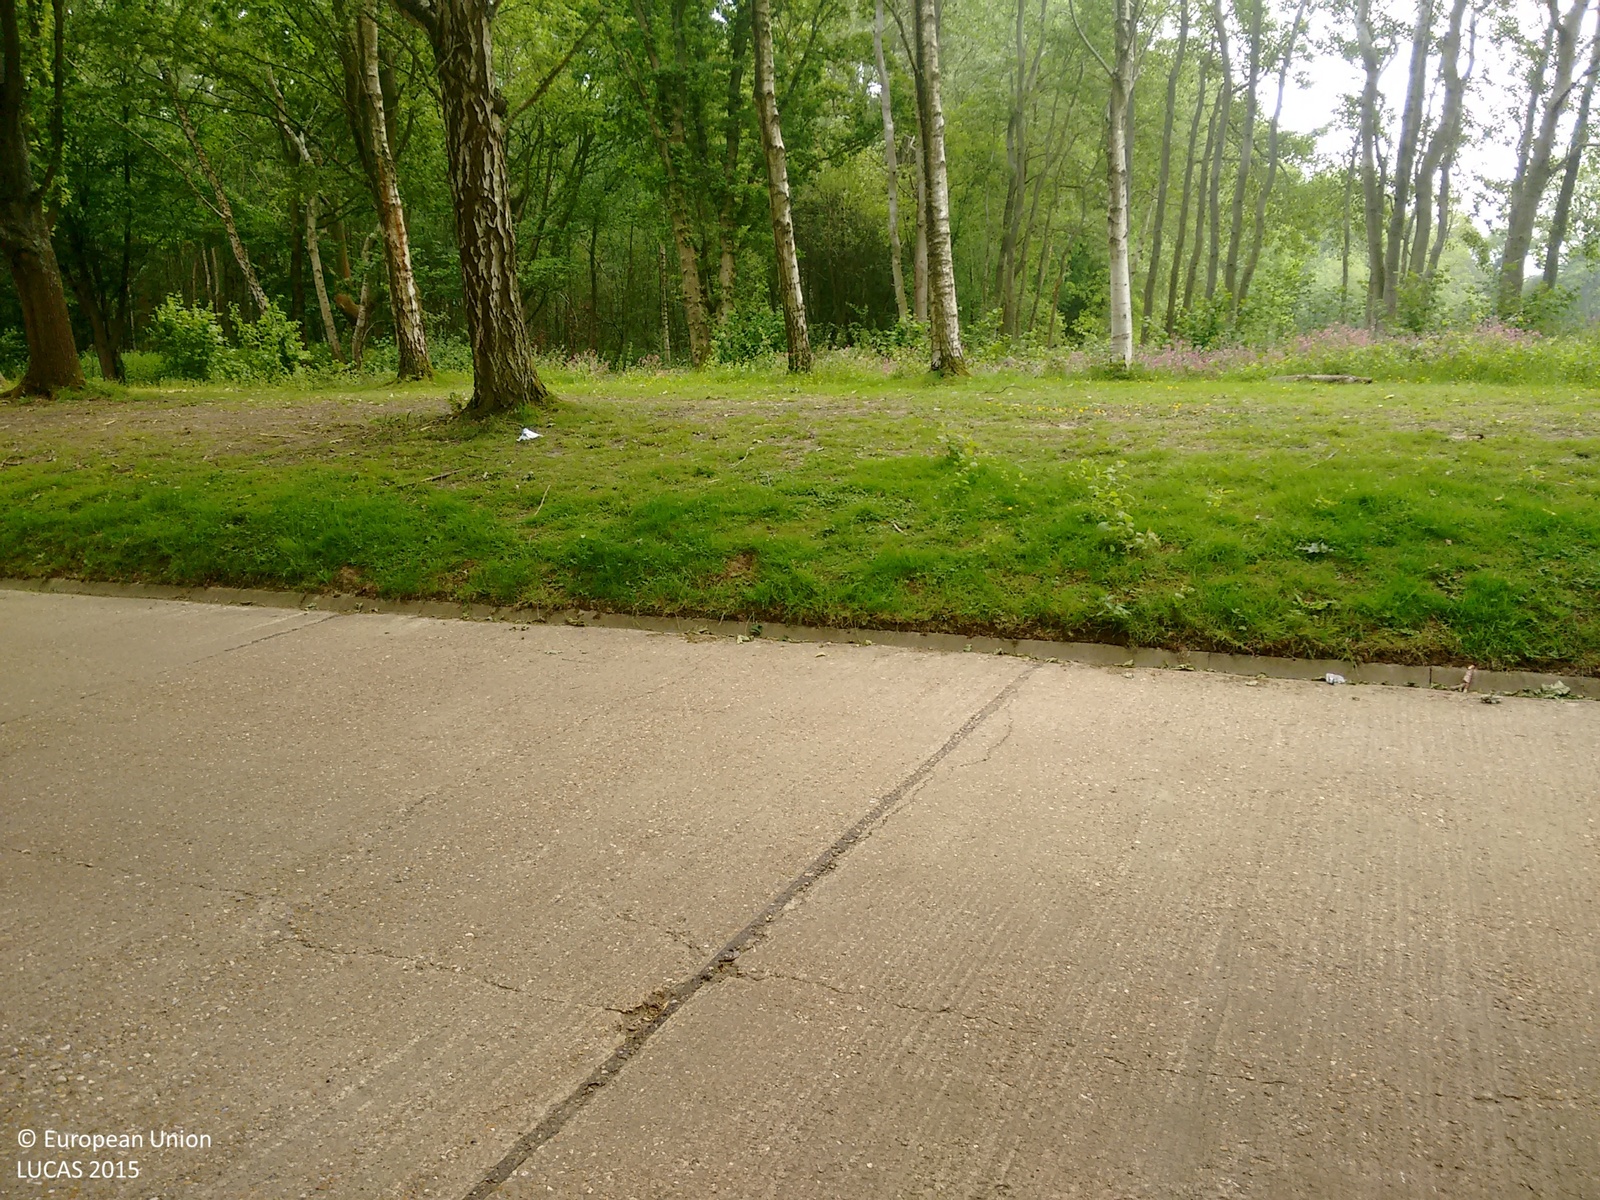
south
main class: Woodland
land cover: Broadleaved woodland
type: mesophytic deciduous forest
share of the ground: > 75 %
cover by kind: broadleaved forest trees 90 %, shrubs 10 %
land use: Waste treatment
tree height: > 5 m
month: June
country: GB
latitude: 51.0816
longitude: 0.3927
